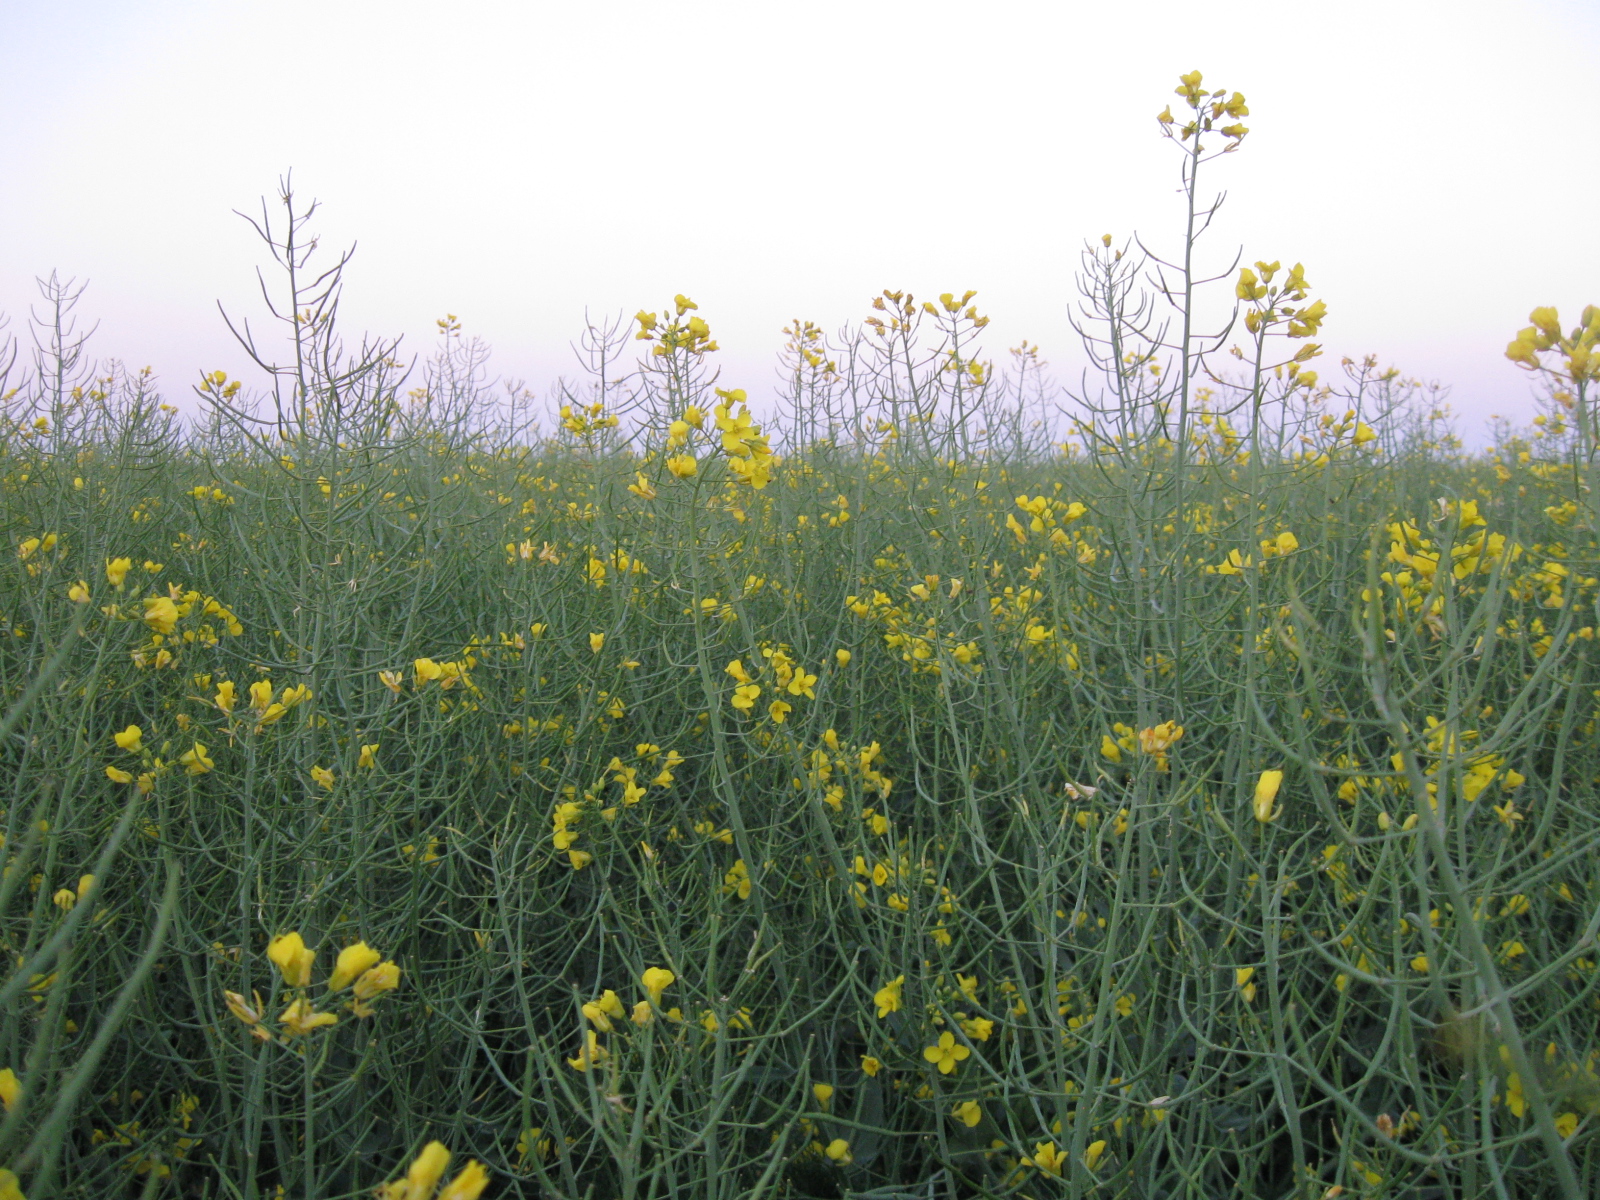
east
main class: Cropland
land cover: Rape and turnip rape
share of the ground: > 75 %
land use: Agriculture (excluding fallow land and kitchen gardens)
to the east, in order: Rape and turnip rape
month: June
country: LT
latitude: 54.4827
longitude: 23.8413
